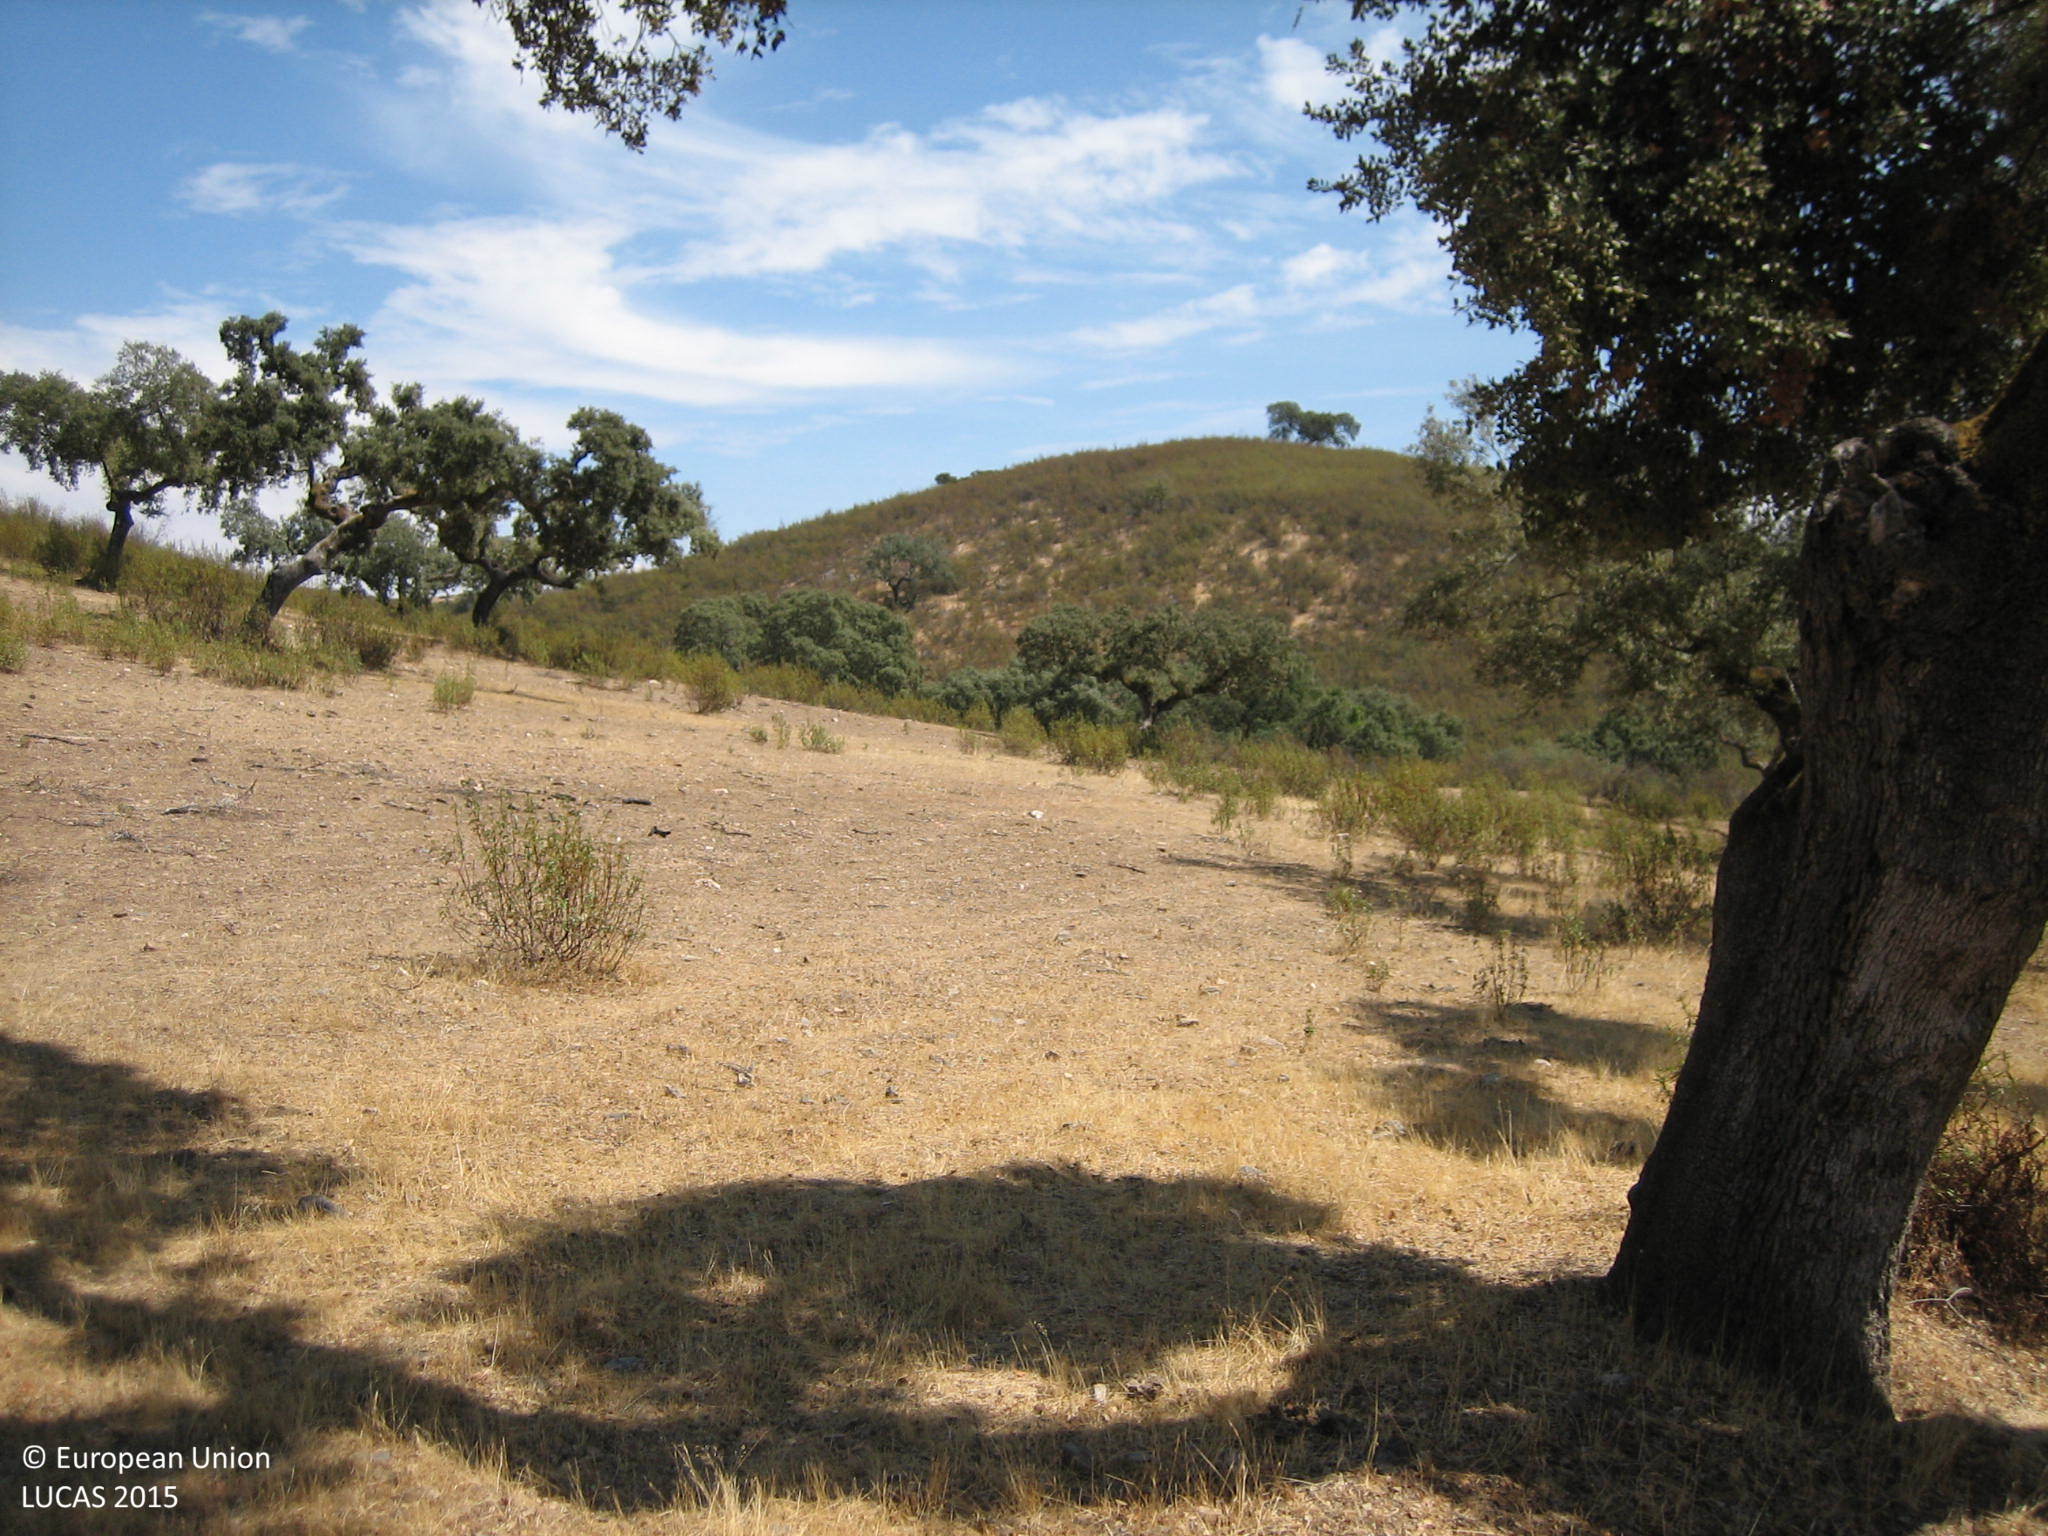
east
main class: Woodland
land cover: Broadleaved woodland
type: broadleaved evergreen forest
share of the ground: 10 - 25 %
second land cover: Grassland without tree/shrub cover
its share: 50 - 75 %
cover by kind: herbaceous plants 50 %, unconsolidated bare surface 25 %, broadleaved forest trees 20 %, shrubs 5 %
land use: Forestry
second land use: Agriculture (excluding fallow land and kitchen gardens)
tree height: > 5 m
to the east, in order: Broadleaved woodland; Grassland without tree/shrub cover; Fences; Broadleaved woodland; Rivers and streams; Shrubland with sparse tree cover
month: September
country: ES
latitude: 38.2159
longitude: -7.1129
